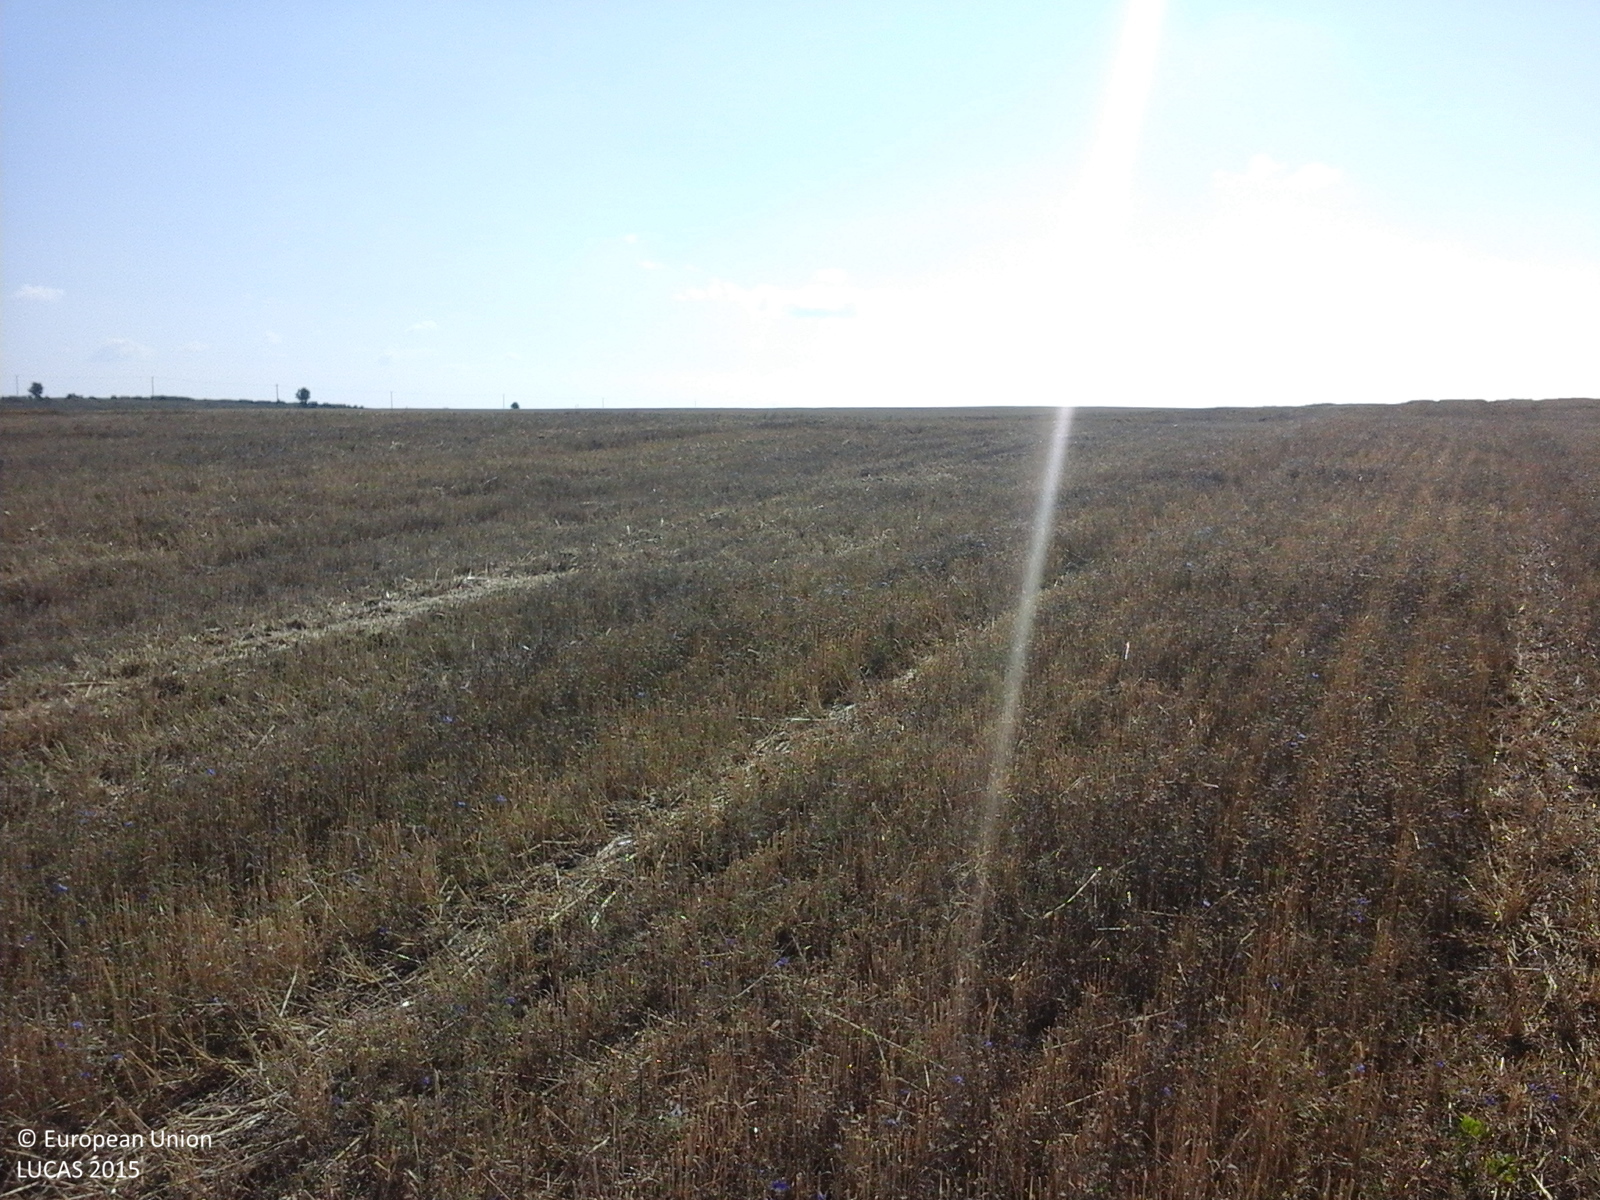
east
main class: Cropland
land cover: Common wheat
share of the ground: > 75 %
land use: Agriculture (excluding fallow land and kitchen gardens)
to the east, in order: Common wheat
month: July
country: RO
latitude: 46.0956
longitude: 27.6916
